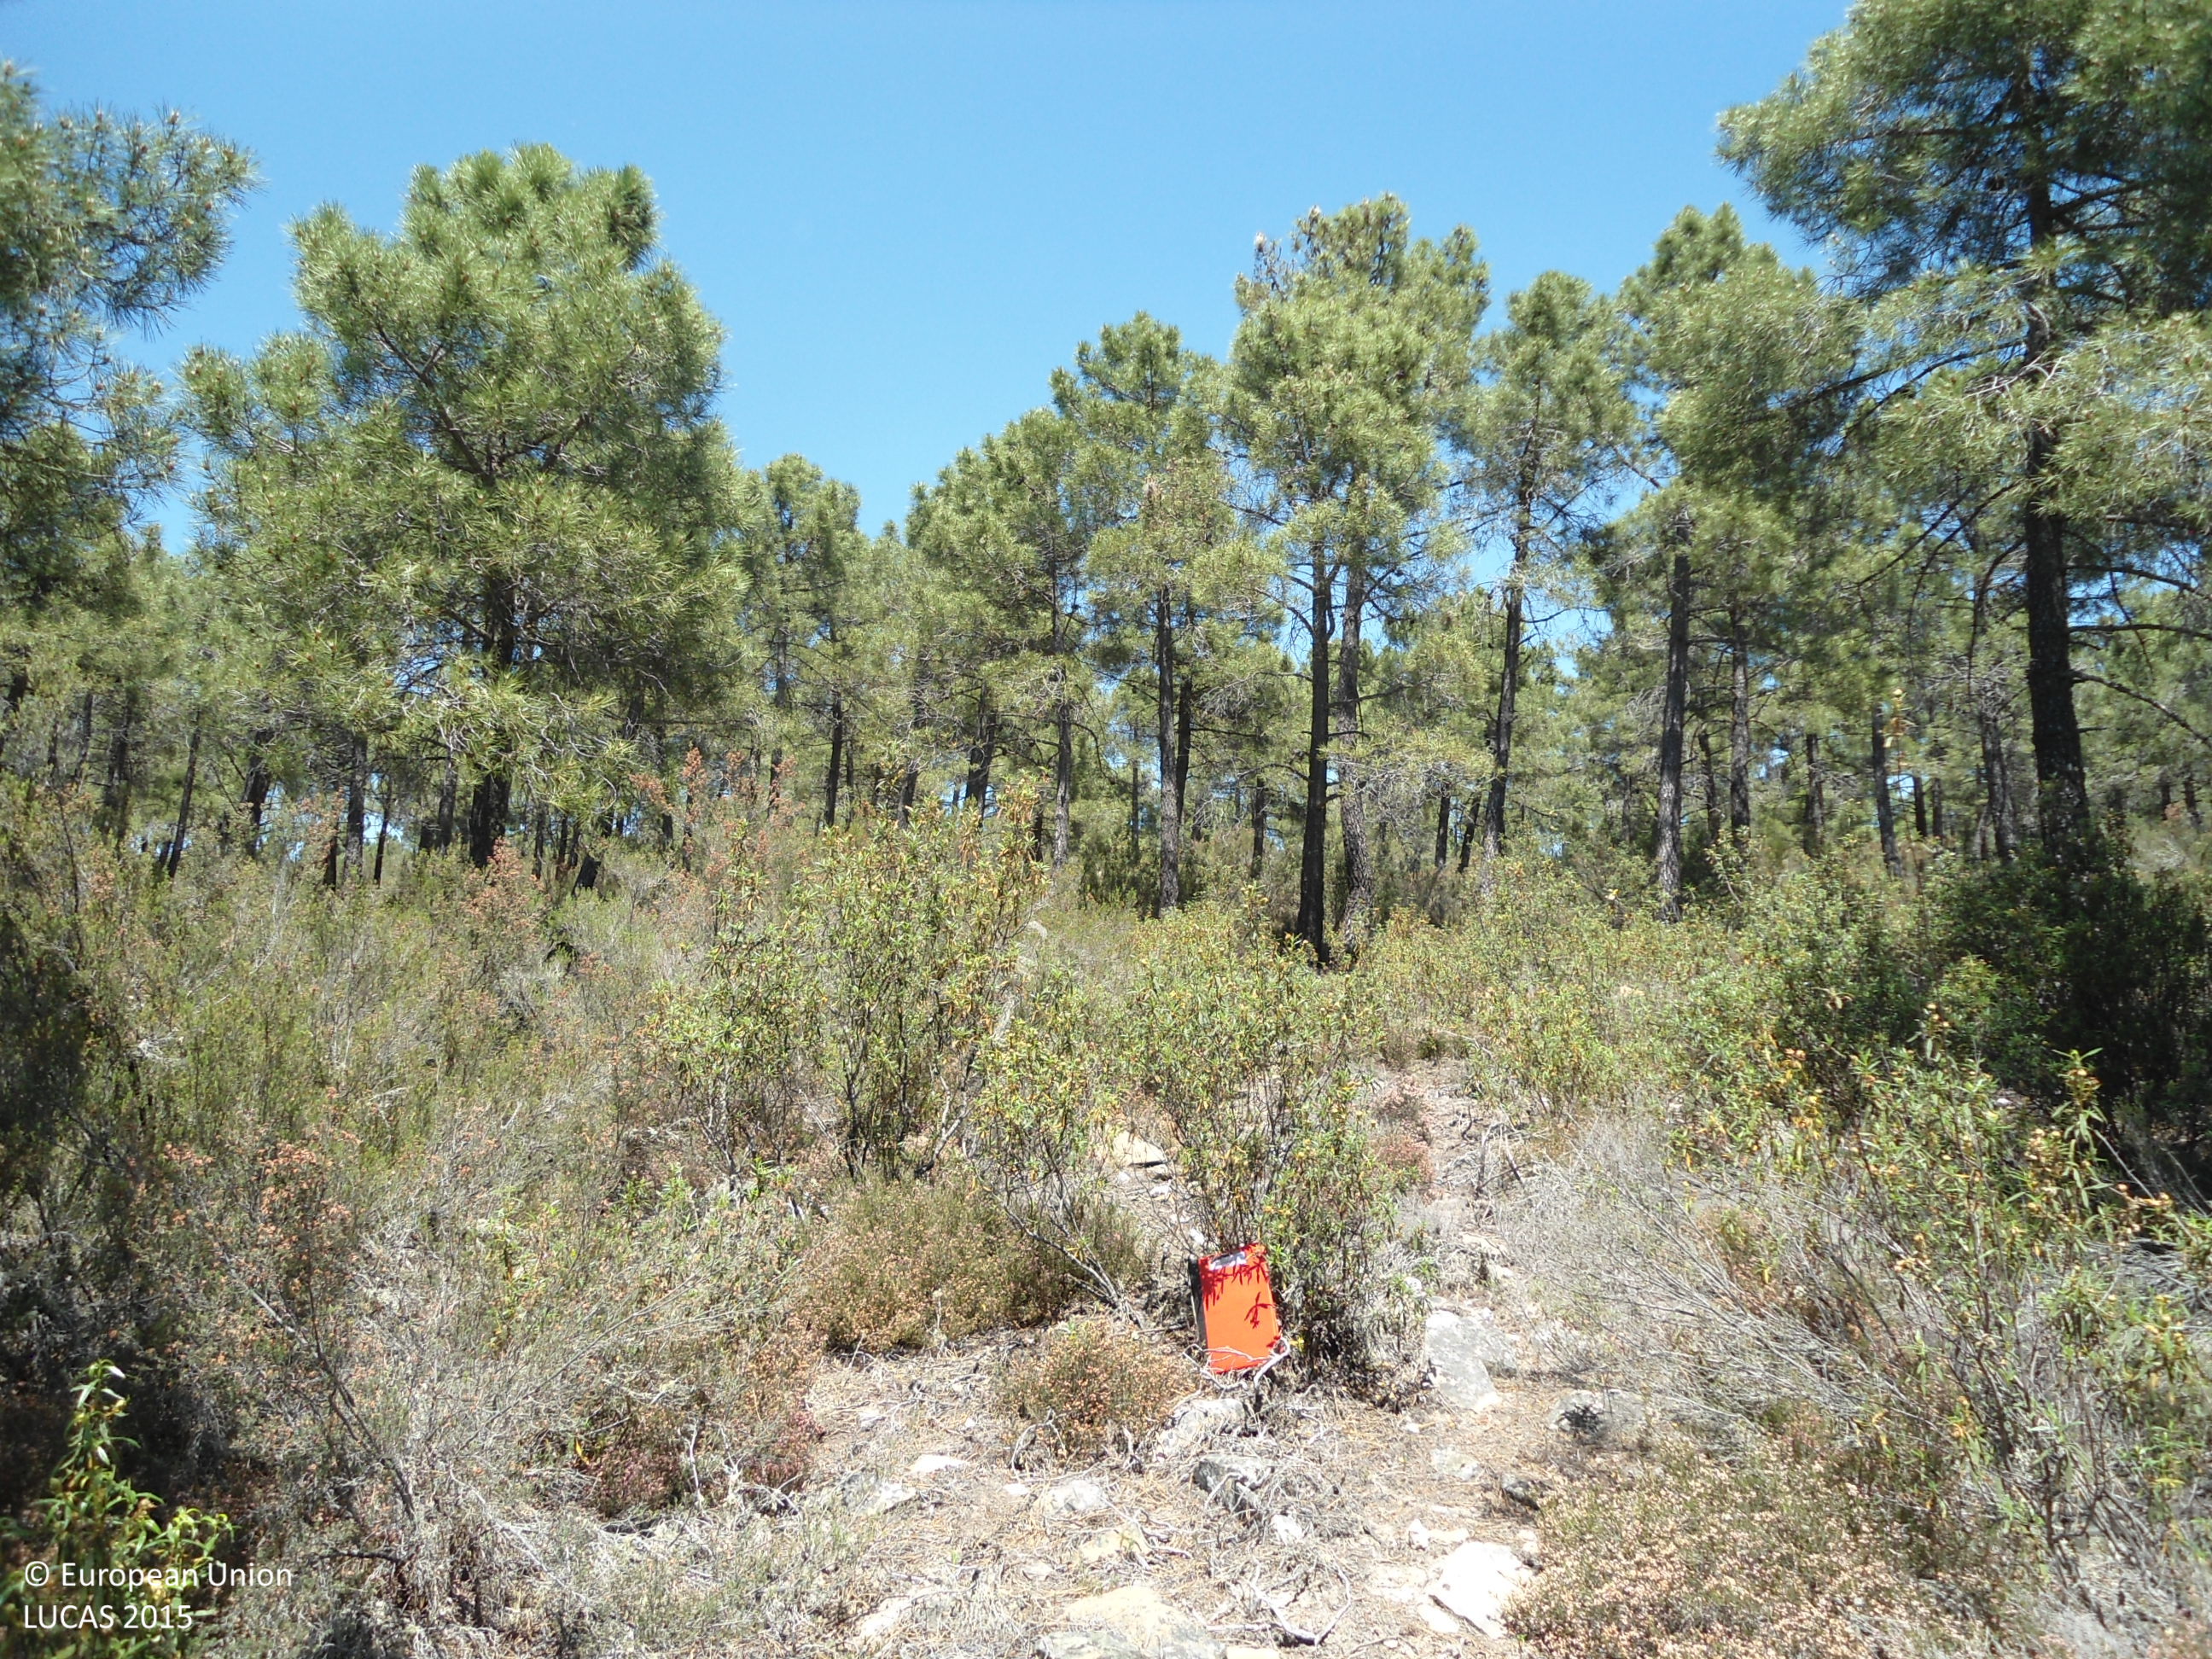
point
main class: Woodland
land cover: Pine dominated coniferous woodland
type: coniferous forest of the mediterranean region
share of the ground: > 75 %
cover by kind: coniferous forest trees 90 %, shrubs 10 %
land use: Forestry
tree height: > 5 m
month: June
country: ES
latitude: 42.1170
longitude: -6.0546
